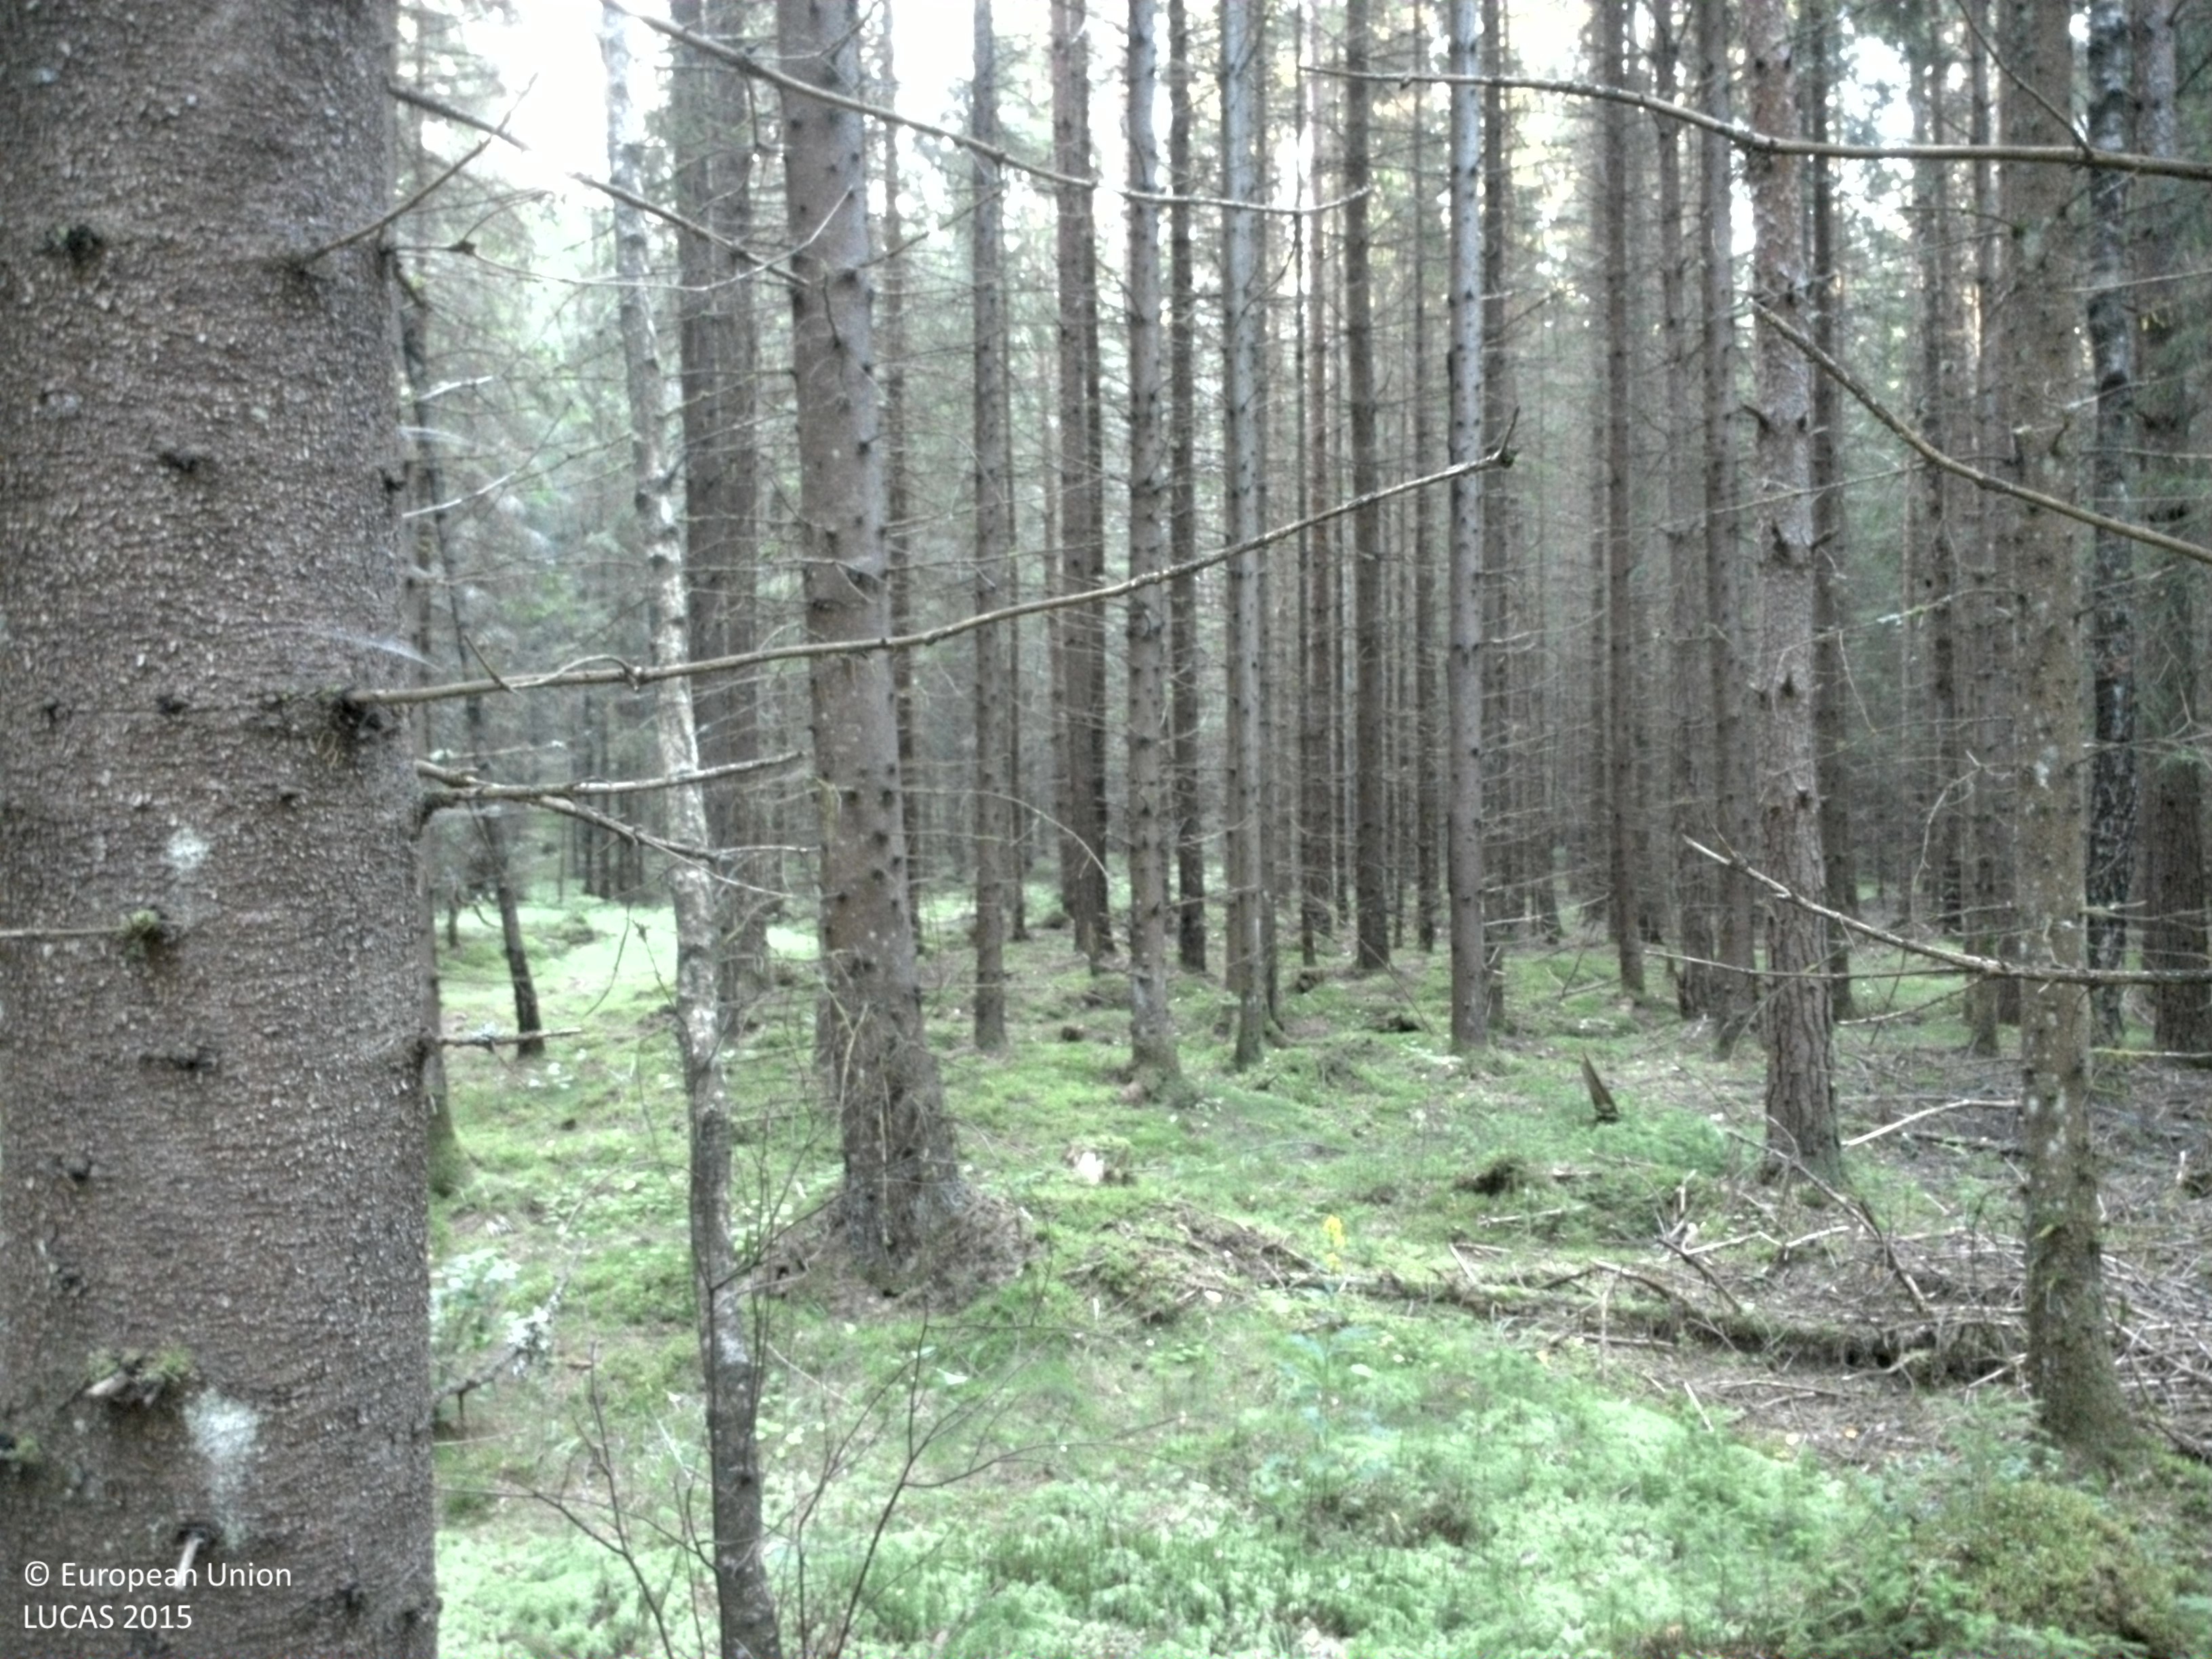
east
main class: Woodland
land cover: Spruce dominated coniferous woodland
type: boreal forest
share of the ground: 50 - 75 %
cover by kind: coniferous forest trees 75 %, lichens and mosses 20 %, shrubs 5 %
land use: Forestry
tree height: > 5 m
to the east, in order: Spruce dominated coniferous woodland; Ditches and canals; Spruce dominated coniferous woodland; Tracks; Spruce dominated coniferous woodland; Rivers and streams; Spruce dominated coniferous woodland; Rock outcrops; Spruce dominated coniferous woodland; Rock outcrops; Spruce dominated coniferous woodland; Pine dominated coniferous woodland
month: August
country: SE
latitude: 59.4355
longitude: 13.4653
